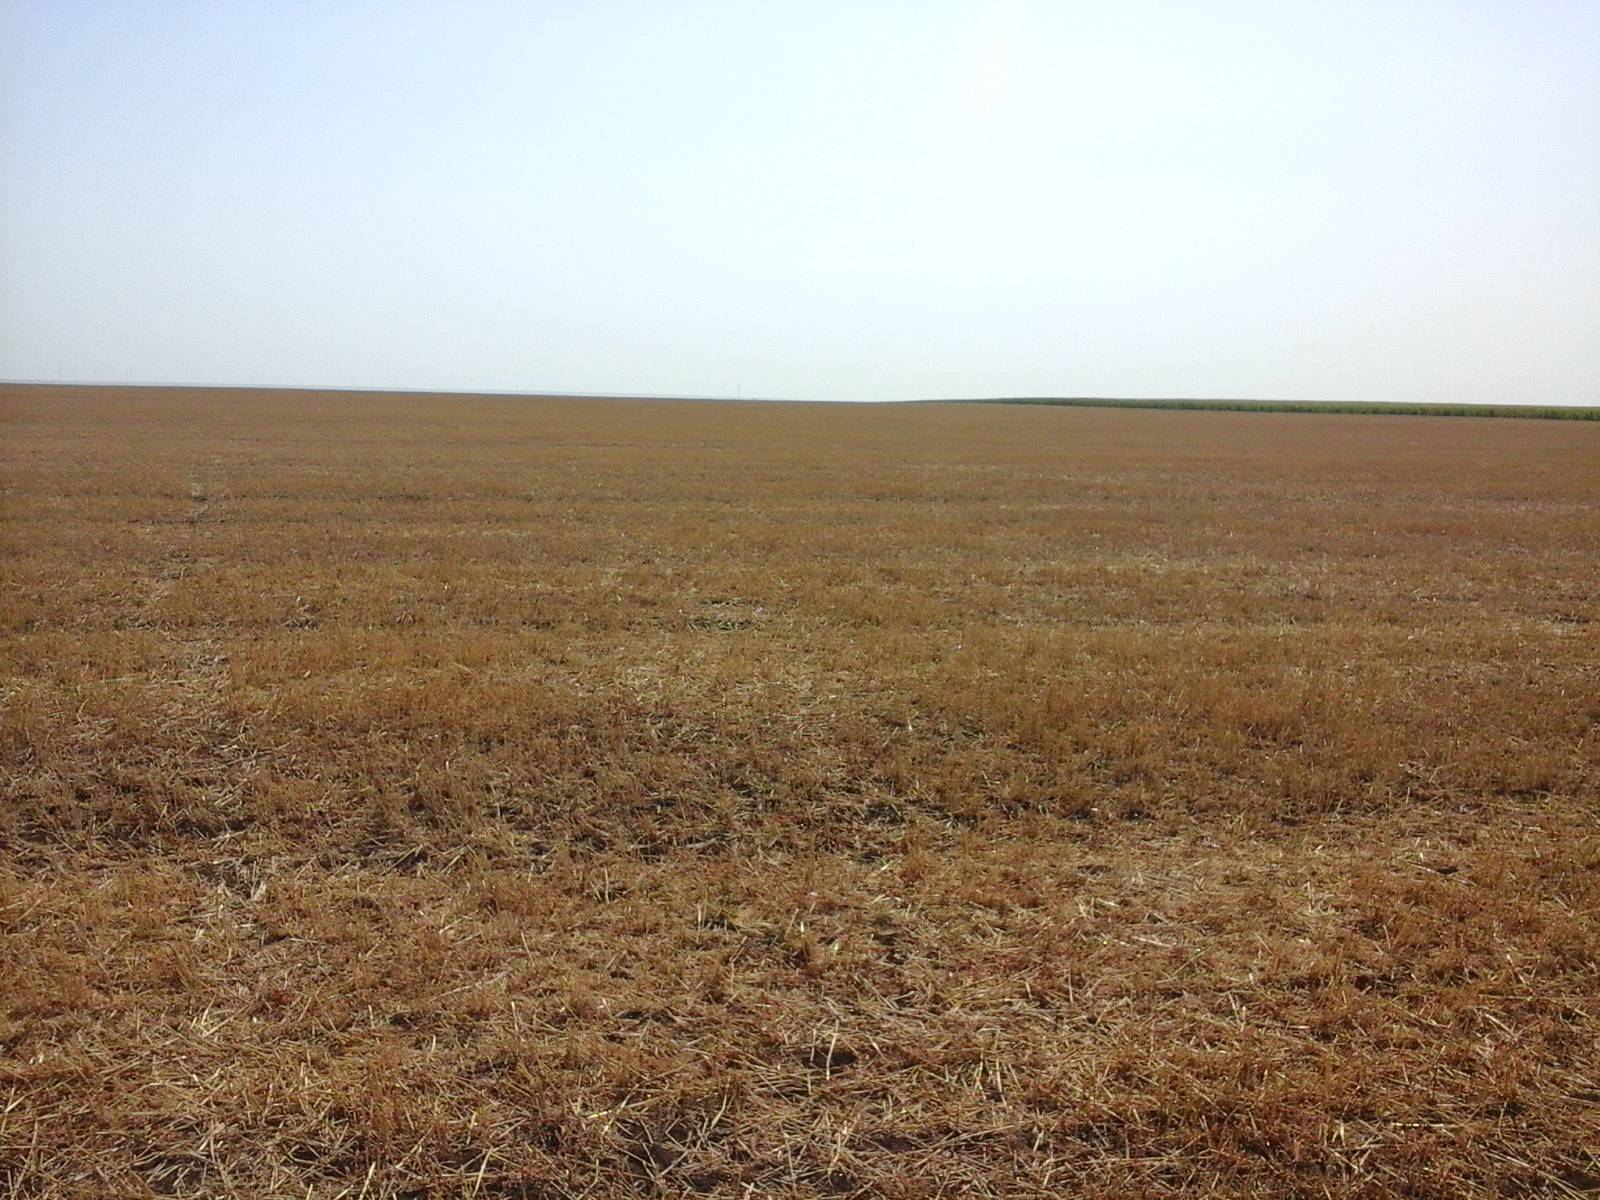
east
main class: Cropland
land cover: Common wheat
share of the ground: > 75 %
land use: Agriculture (excluding fallow land and kitchen gardens)
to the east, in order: Common wheat
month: August
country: RO
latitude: 45.7817
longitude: 27.5868
